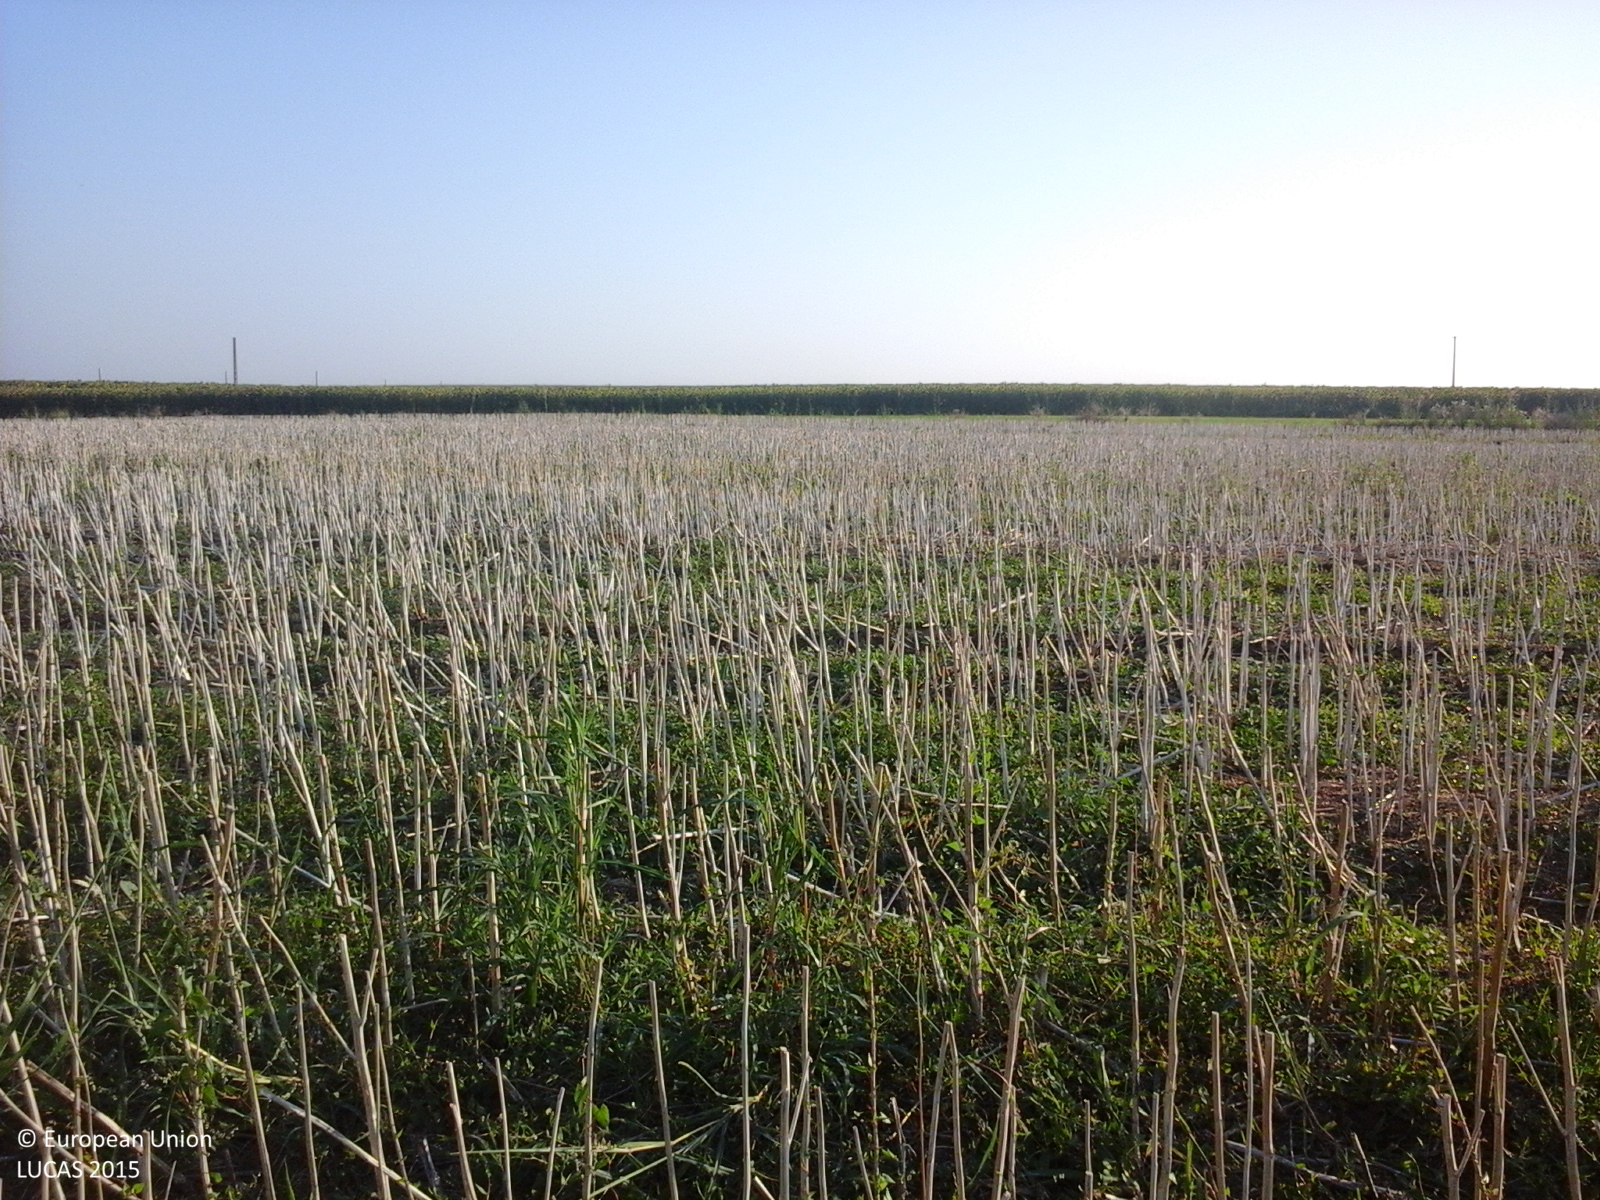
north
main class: Cropland
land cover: Rape and turnip rape
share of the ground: < 10 %
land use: Agriculture (excluding fallow land and kitchen gardens)
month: July
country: RO
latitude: 44.5239
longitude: 27.1830
